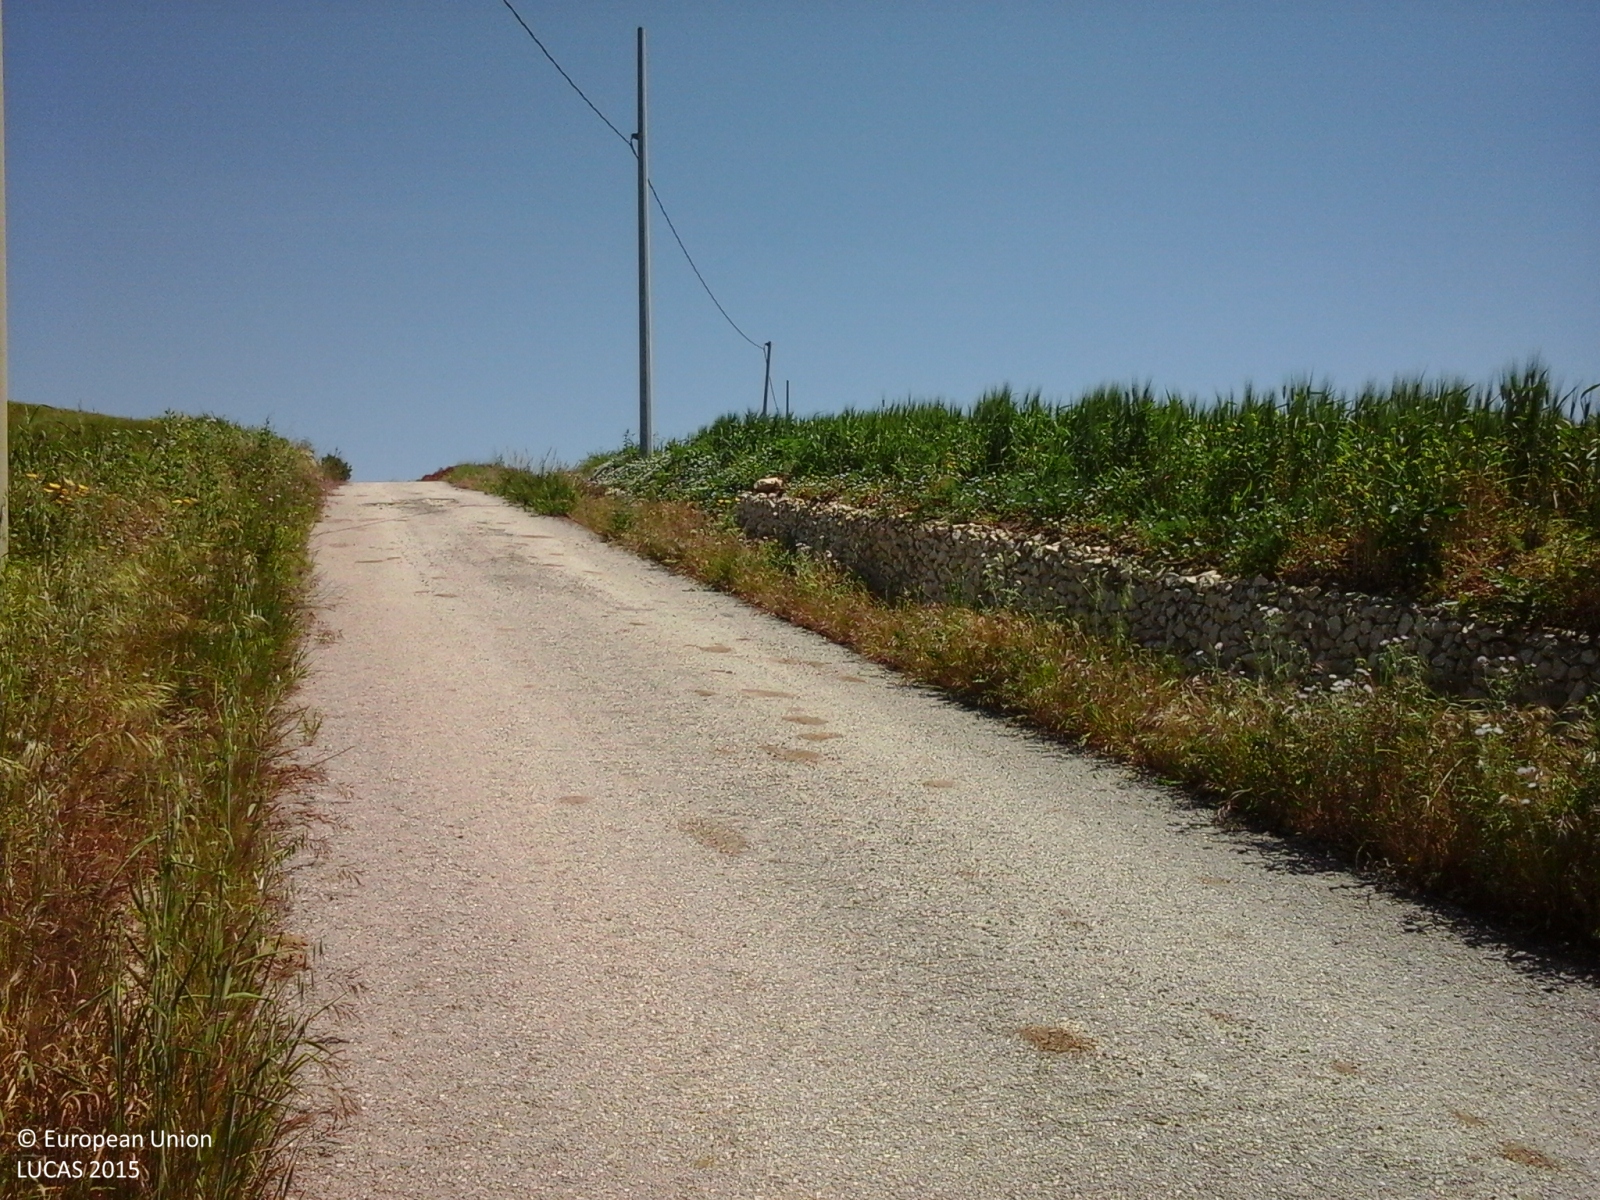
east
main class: Cropland
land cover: Durum wheat
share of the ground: > 75 %
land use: Agriculture (excluding fallow land and kitchen gardens)
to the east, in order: Durum wheat; Grass margins; Durum wheat; Grass margins; Artificial constructions; Paved roads, cycling and walking lanes; Grassland without tree/shrub cover
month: April
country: IT
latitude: 37.4077
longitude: 13.5764
